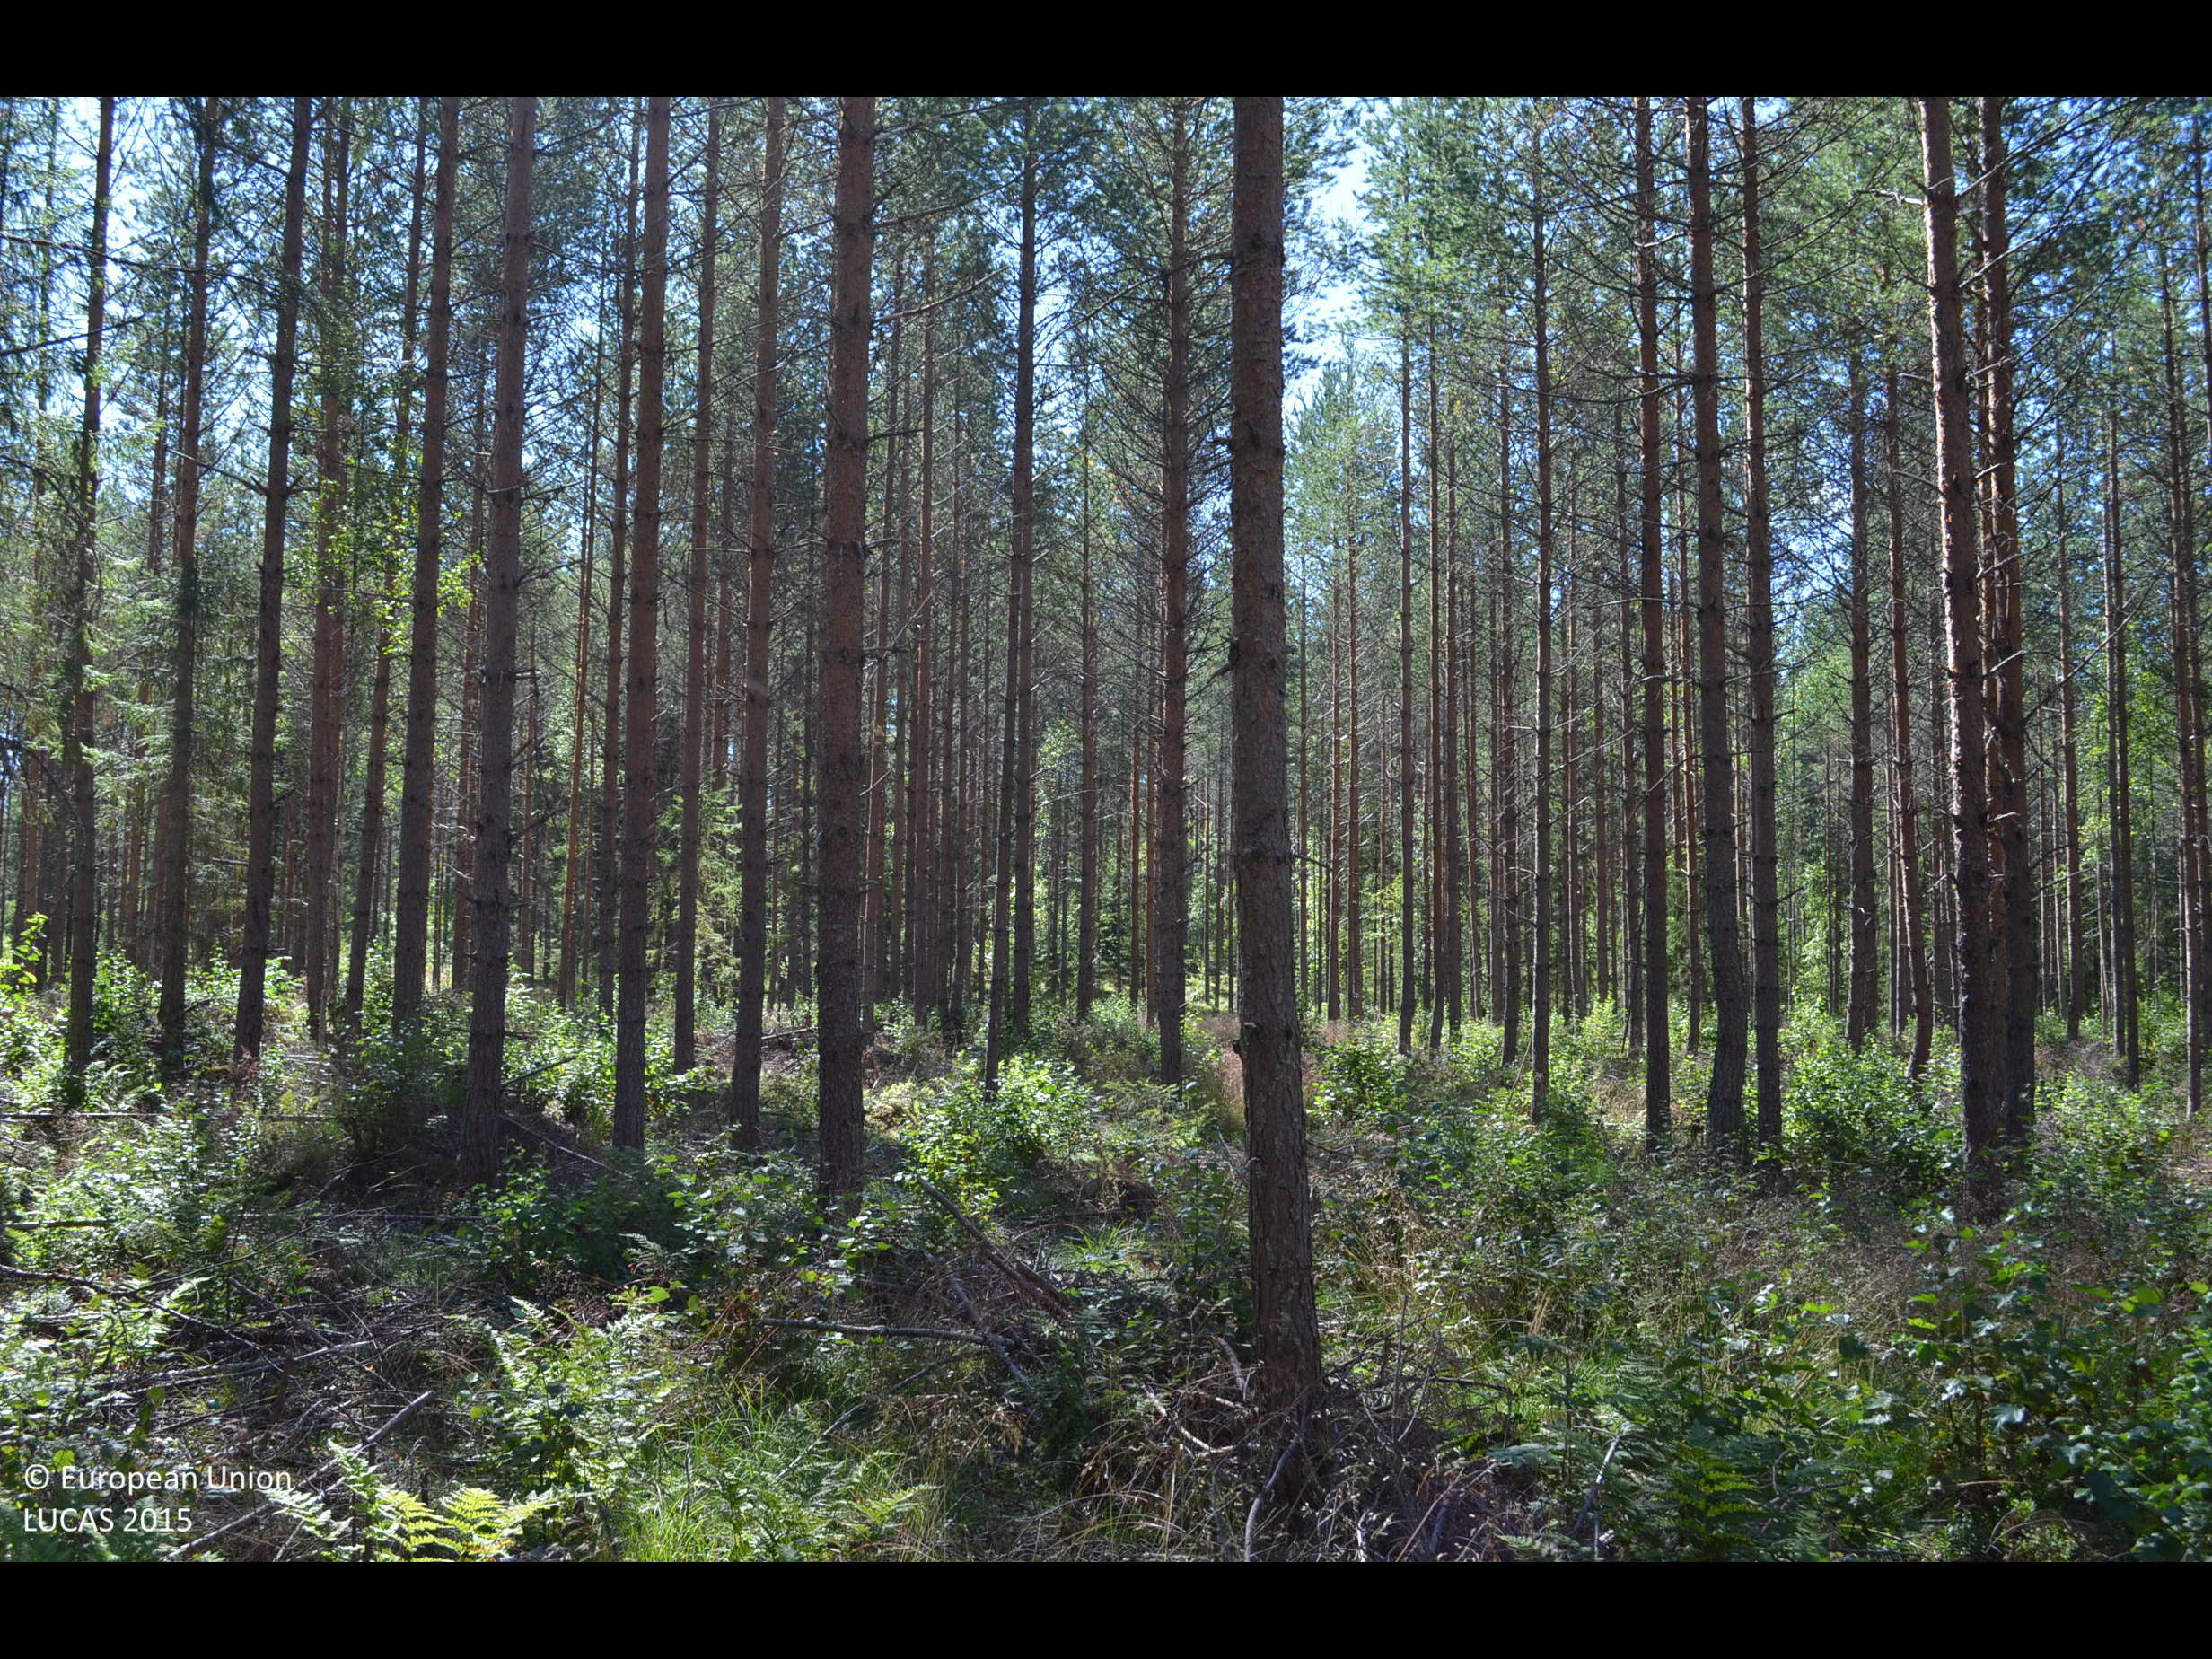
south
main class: Woodland
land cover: Pine dominated coniferous woodland
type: boreal forest
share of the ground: 50 - 75 %
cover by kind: coniferous forest trees 70 %, shrubs 20 %, herbaceous plants 5 %
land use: Forestry
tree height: > 5 m
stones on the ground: < 10 %
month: August
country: FI
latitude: 62.3456
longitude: 24.3211
